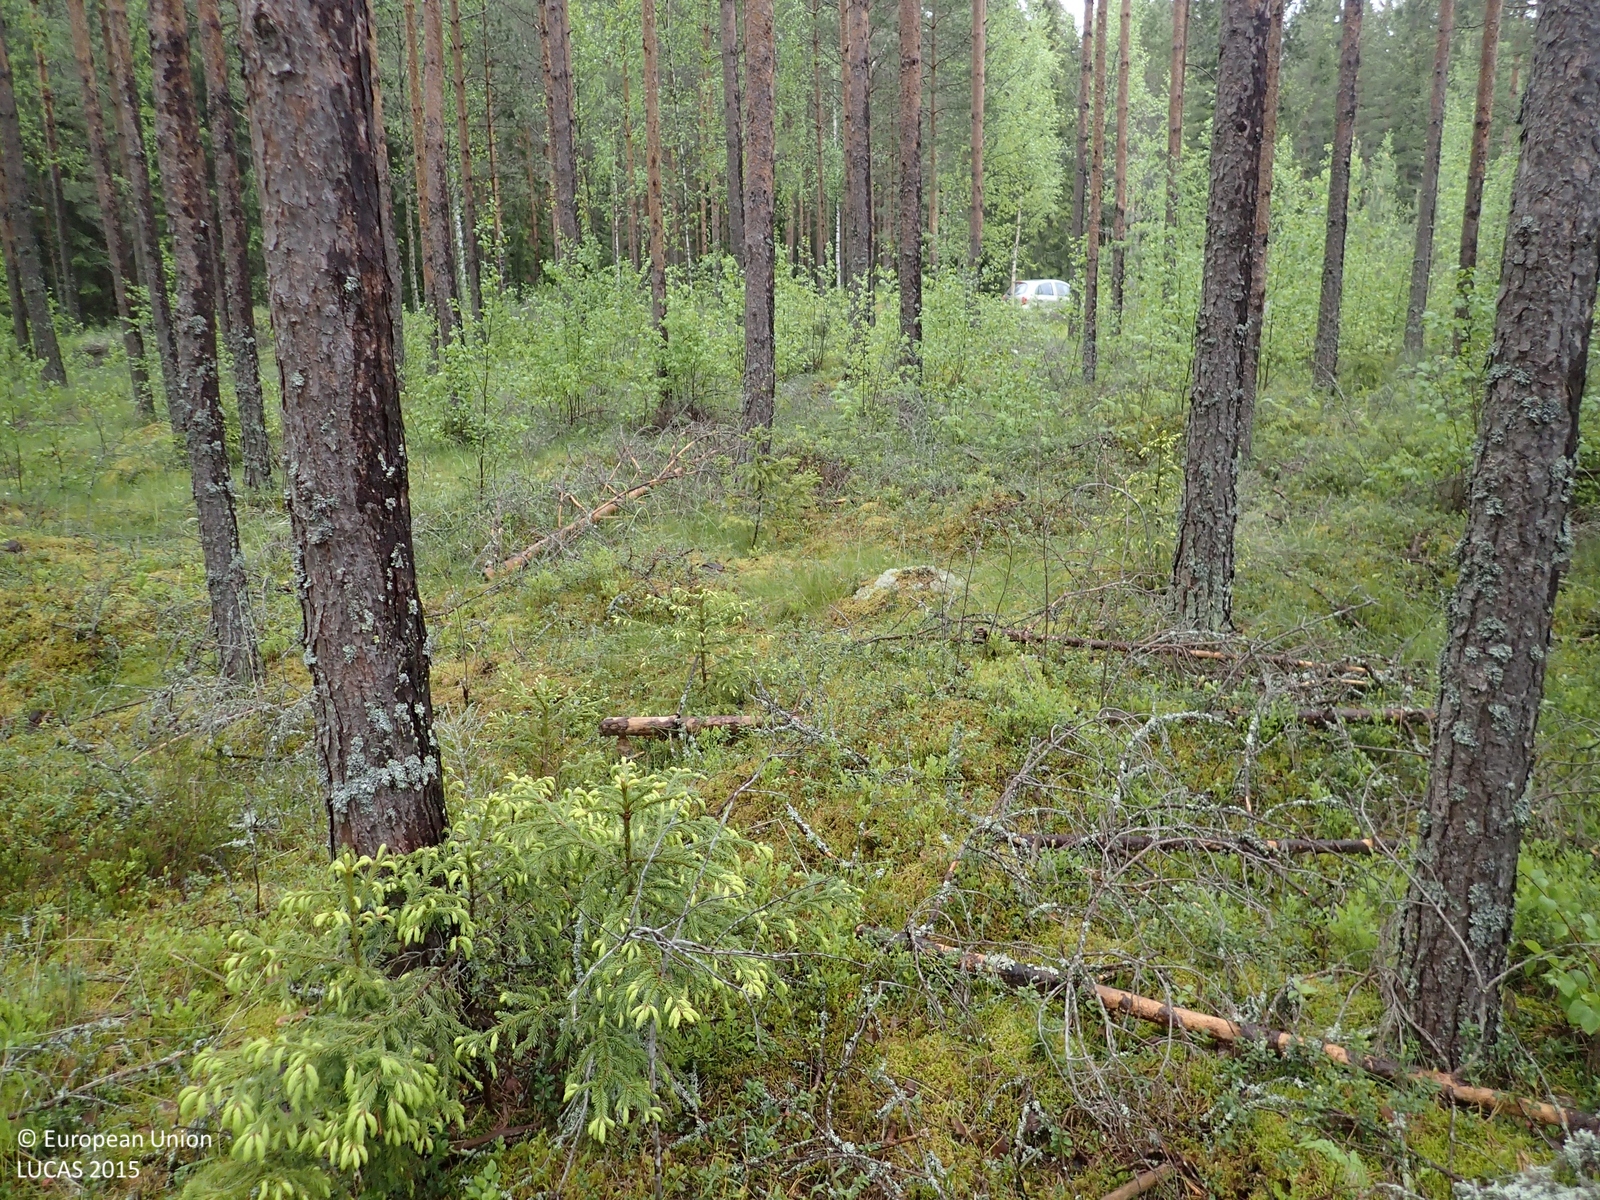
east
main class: Woodland
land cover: Pine dominated coniferous woodland
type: boreal forest
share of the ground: > 75 %
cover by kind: coniferous forest trees 65 %, shrubs 15 %, broadleaved forest trees 10 %, herbaceous plants 5 %, lichens and mosses 5 %
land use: Forestry
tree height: > 5 m
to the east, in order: Pine dominated coniferous woodland; Ditches and canals; Grass margins; Paved roads, cycling and walking lanes; Grass margins; Ditches and canals; Pine dominated coniferous woodland; Spruce dominated coniferous woodland; Grass margins; Tracks; Grassland without tree/shrub cover; Other bare soil
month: June
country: FI
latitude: 62.1785
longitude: 21.6285
